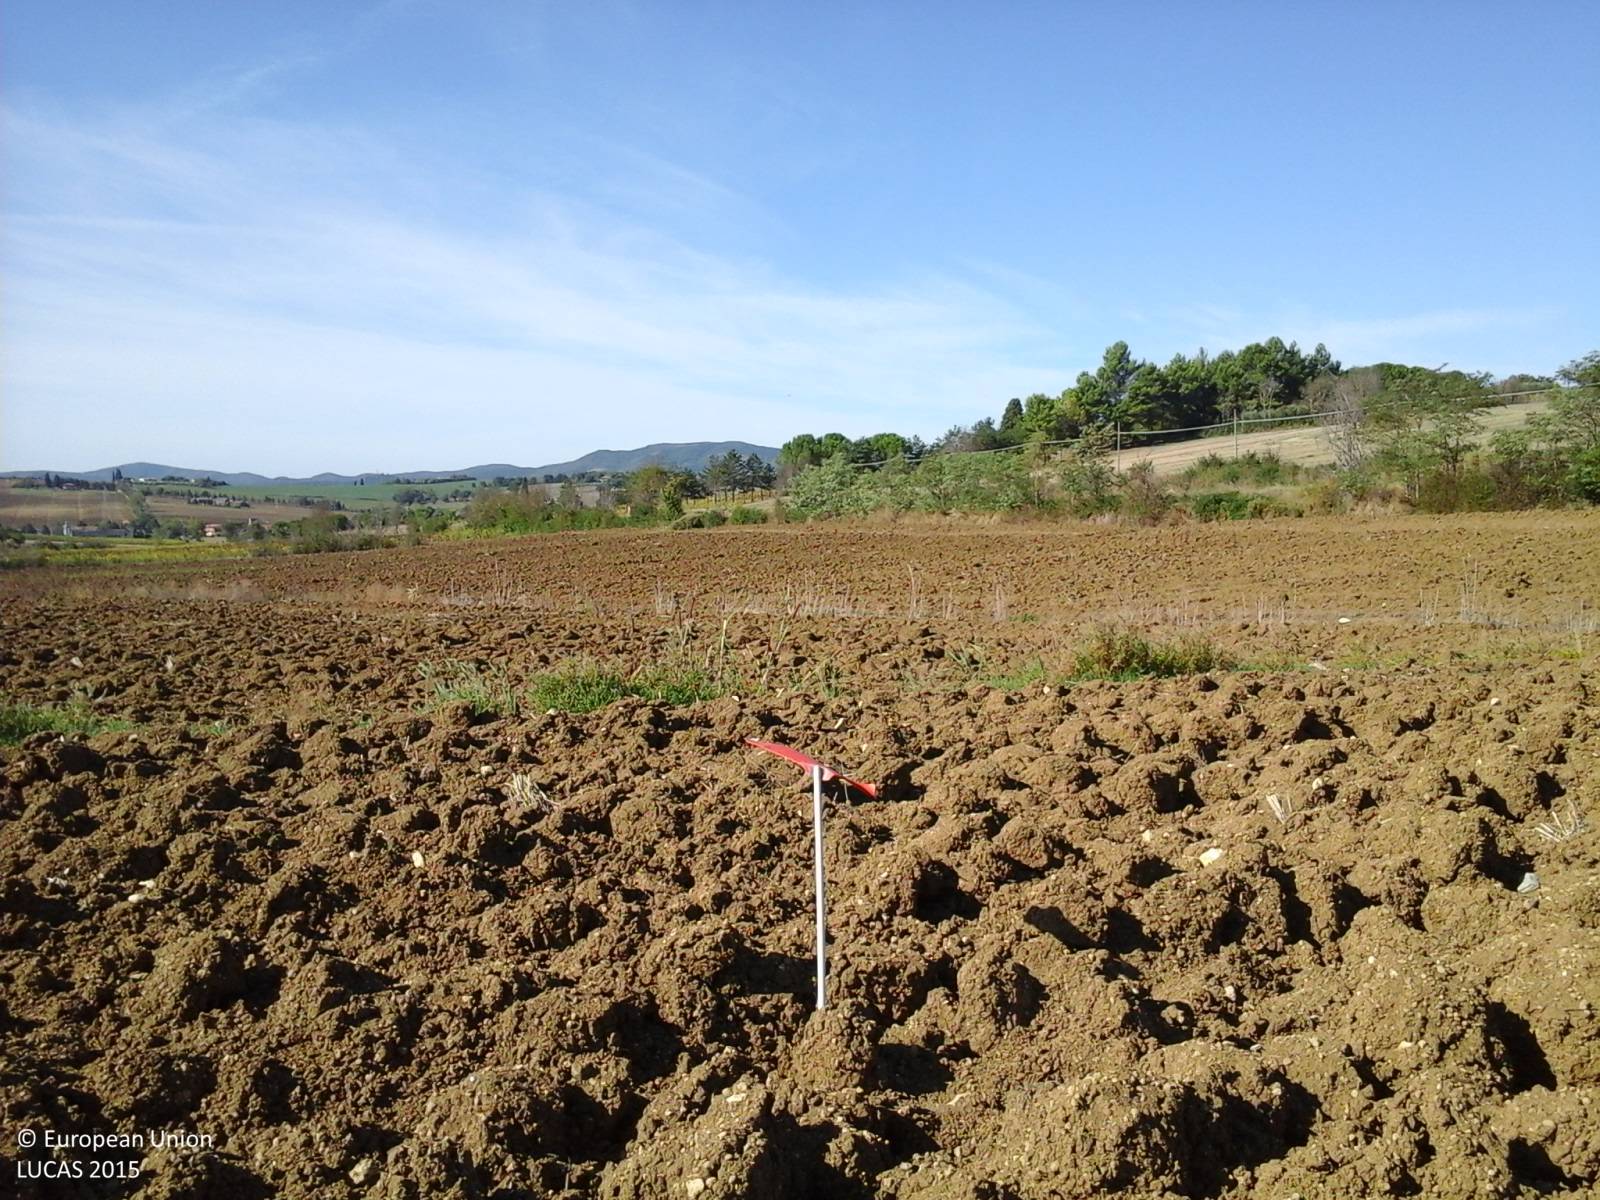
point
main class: Cropland
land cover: Common wheat
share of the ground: < 10 %
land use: Agriculture (excluding fallow land and kitchen gardens)
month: September
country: IT
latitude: 43.0251
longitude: 12.3125
